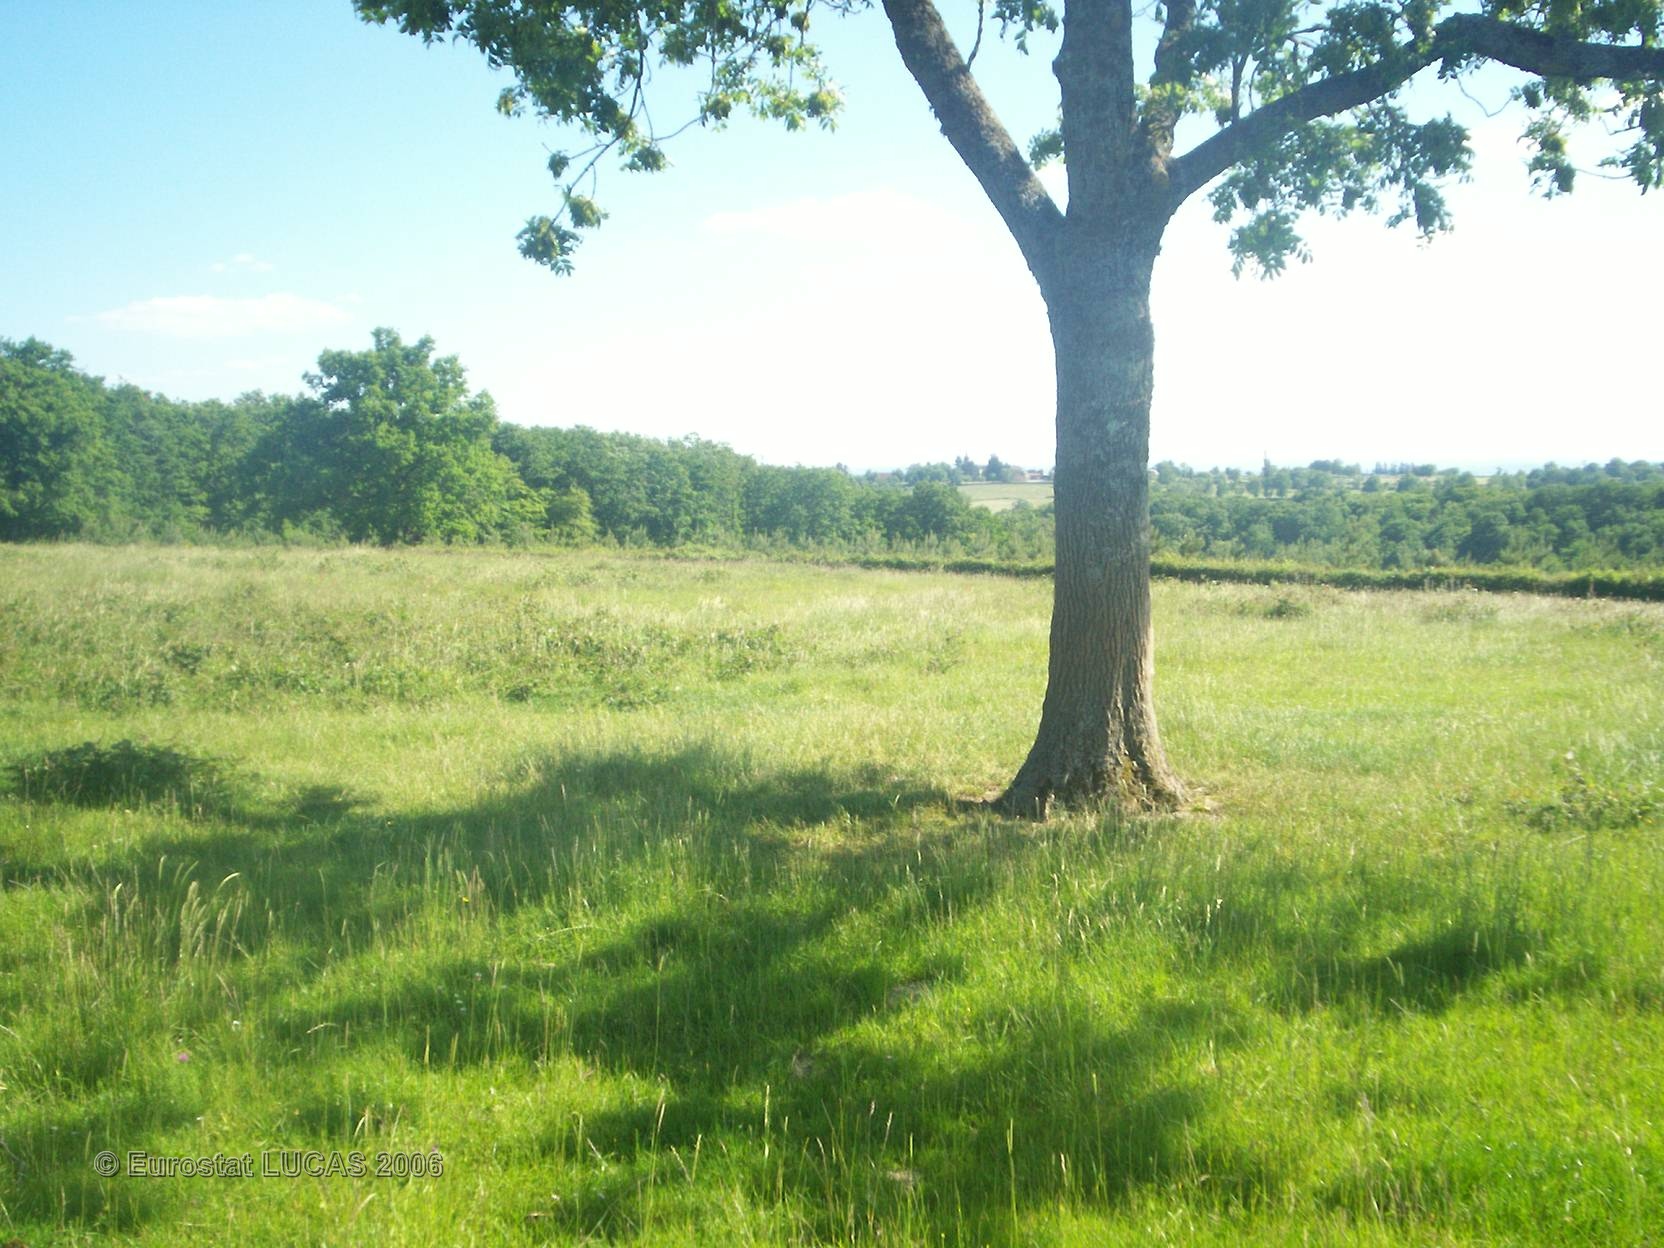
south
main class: Grassland
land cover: Grassland with sparse tree/shrub cover
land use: Agriculture (excluding fallow land and kitchen gardens)
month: June
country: FR
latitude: 46.2963
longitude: 3.1829
